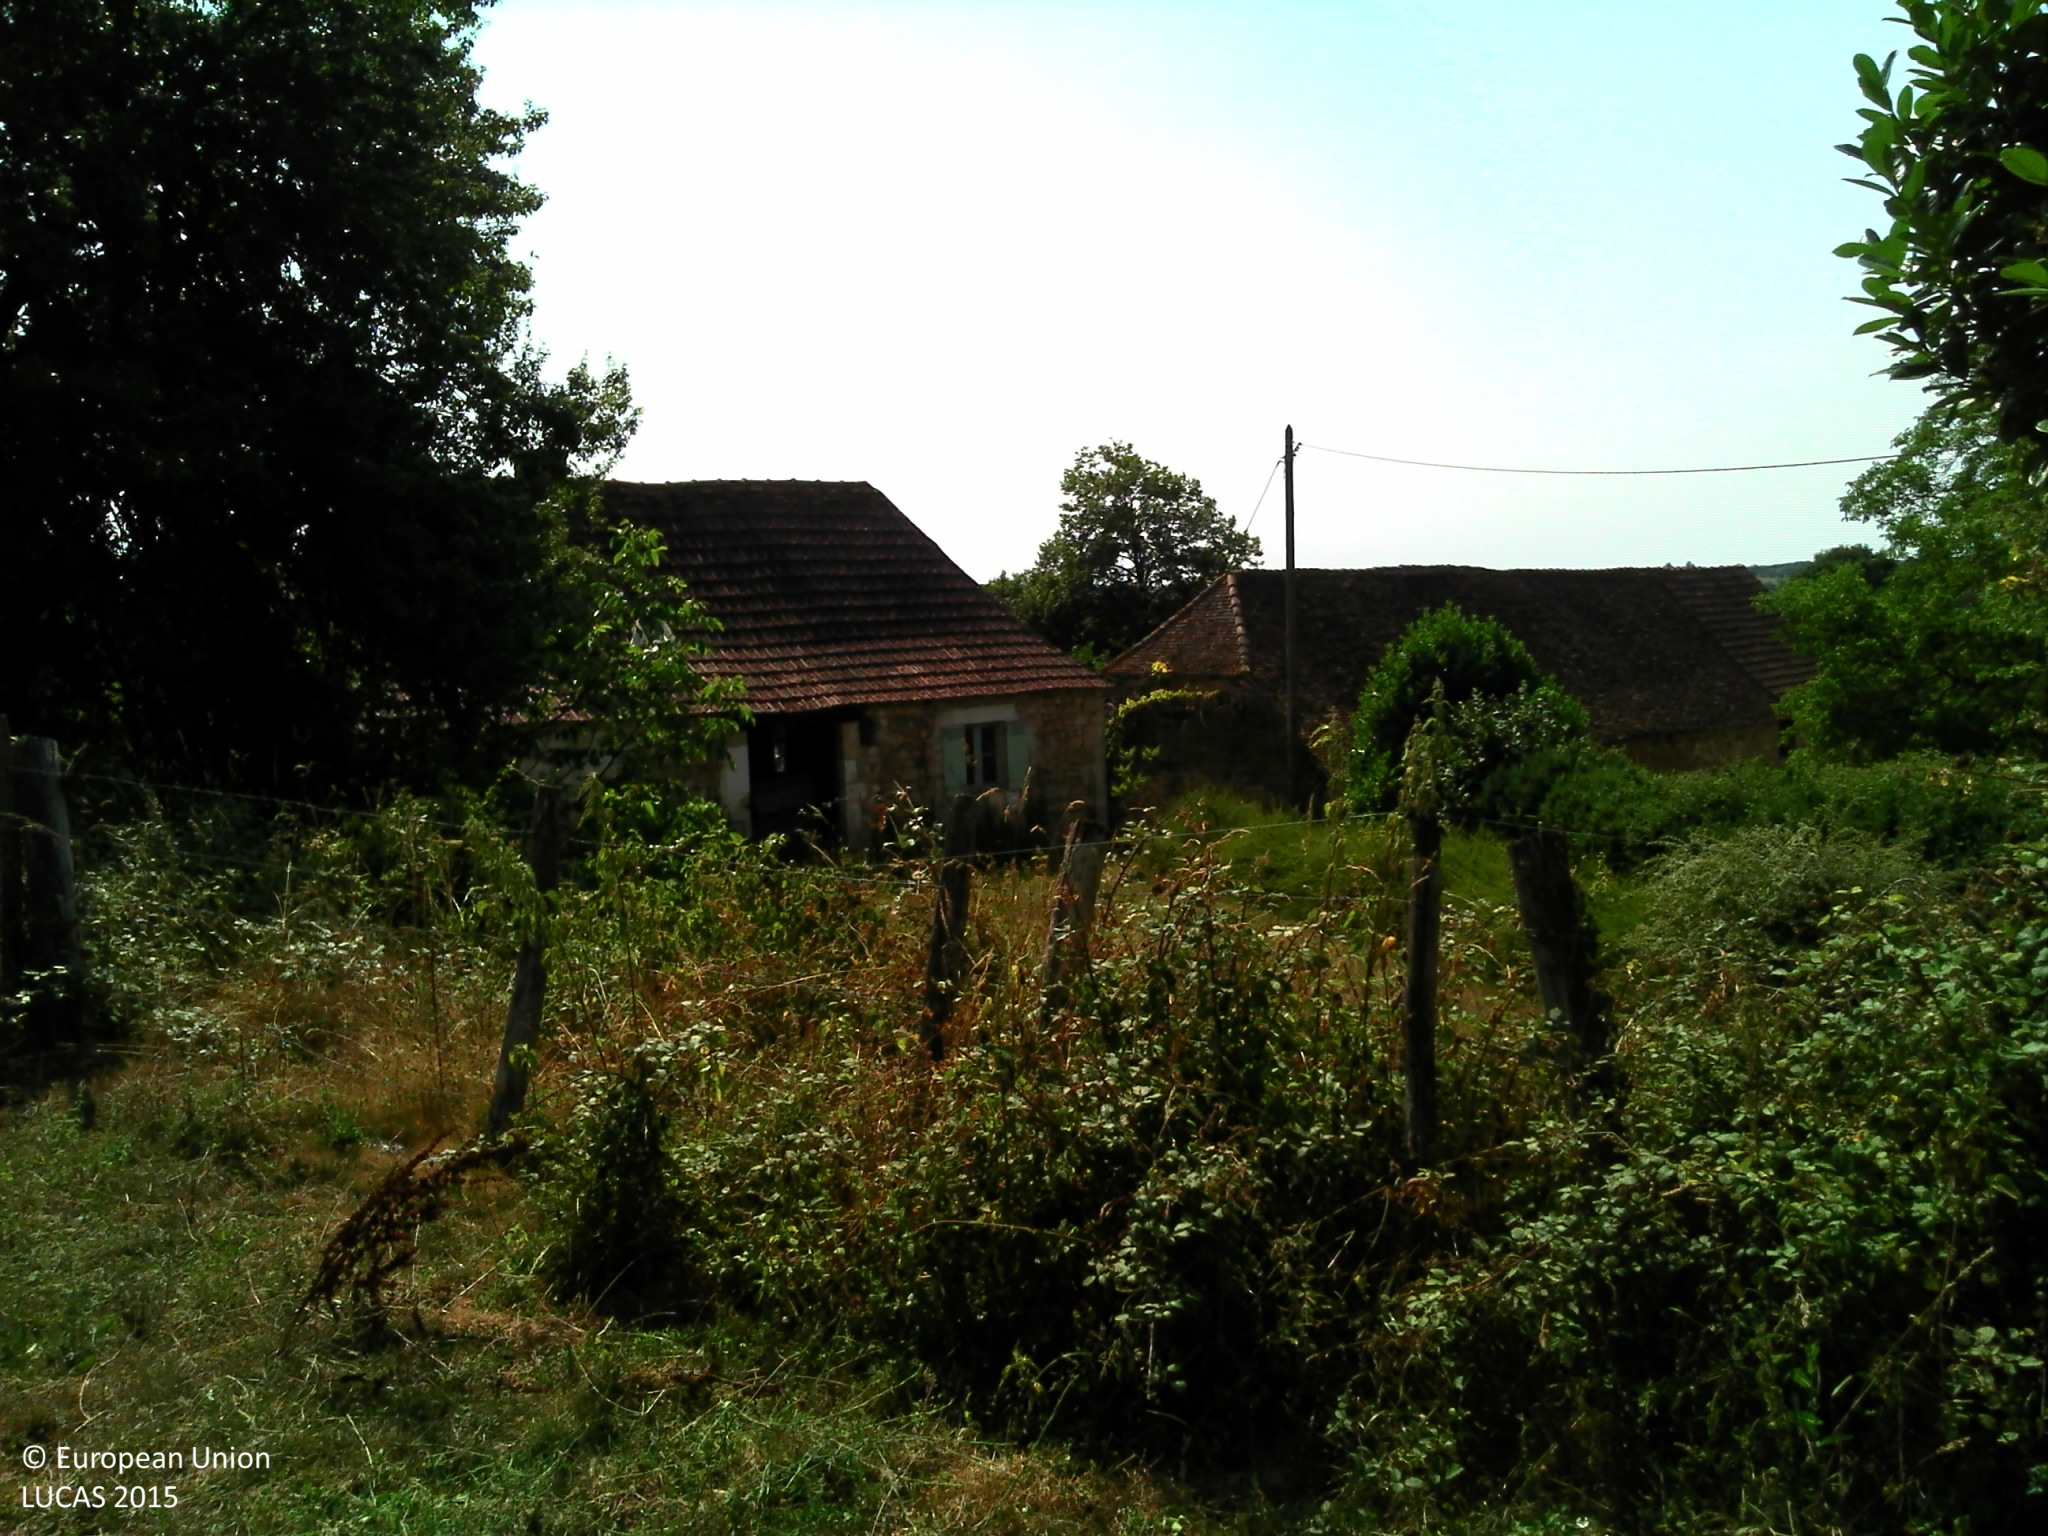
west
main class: Grassland
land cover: Grassland without tree/shrub cover
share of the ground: > 75 %
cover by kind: herbaceous plants 100 %
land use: Agriculture (excluding fallow land and kitchen gardens)
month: July
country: FR
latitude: 45.2242
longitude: 1.1671
